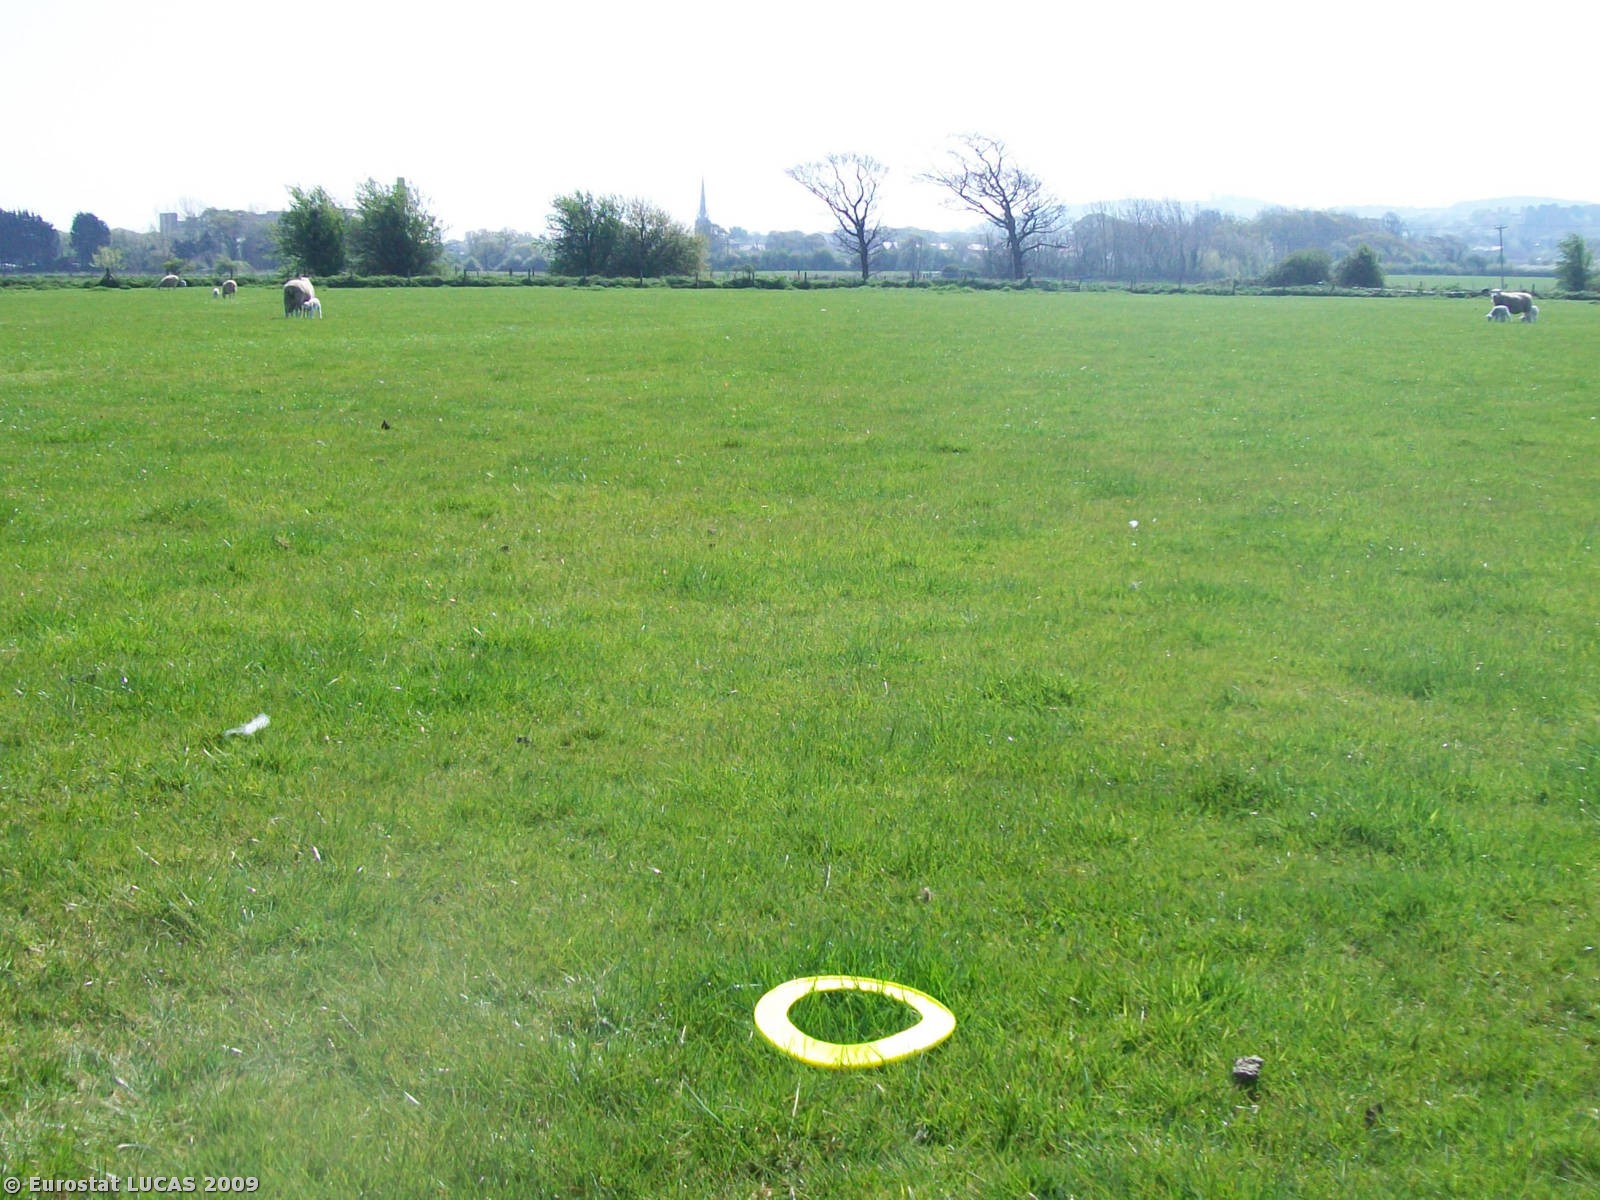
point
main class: Grassland
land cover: Grassland without tree/shrub cover
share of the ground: > 75 %
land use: Agriculture (excluding fallow land and kitchen gardens)
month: April
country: GB
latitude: 53.2791
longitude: -3.5068
